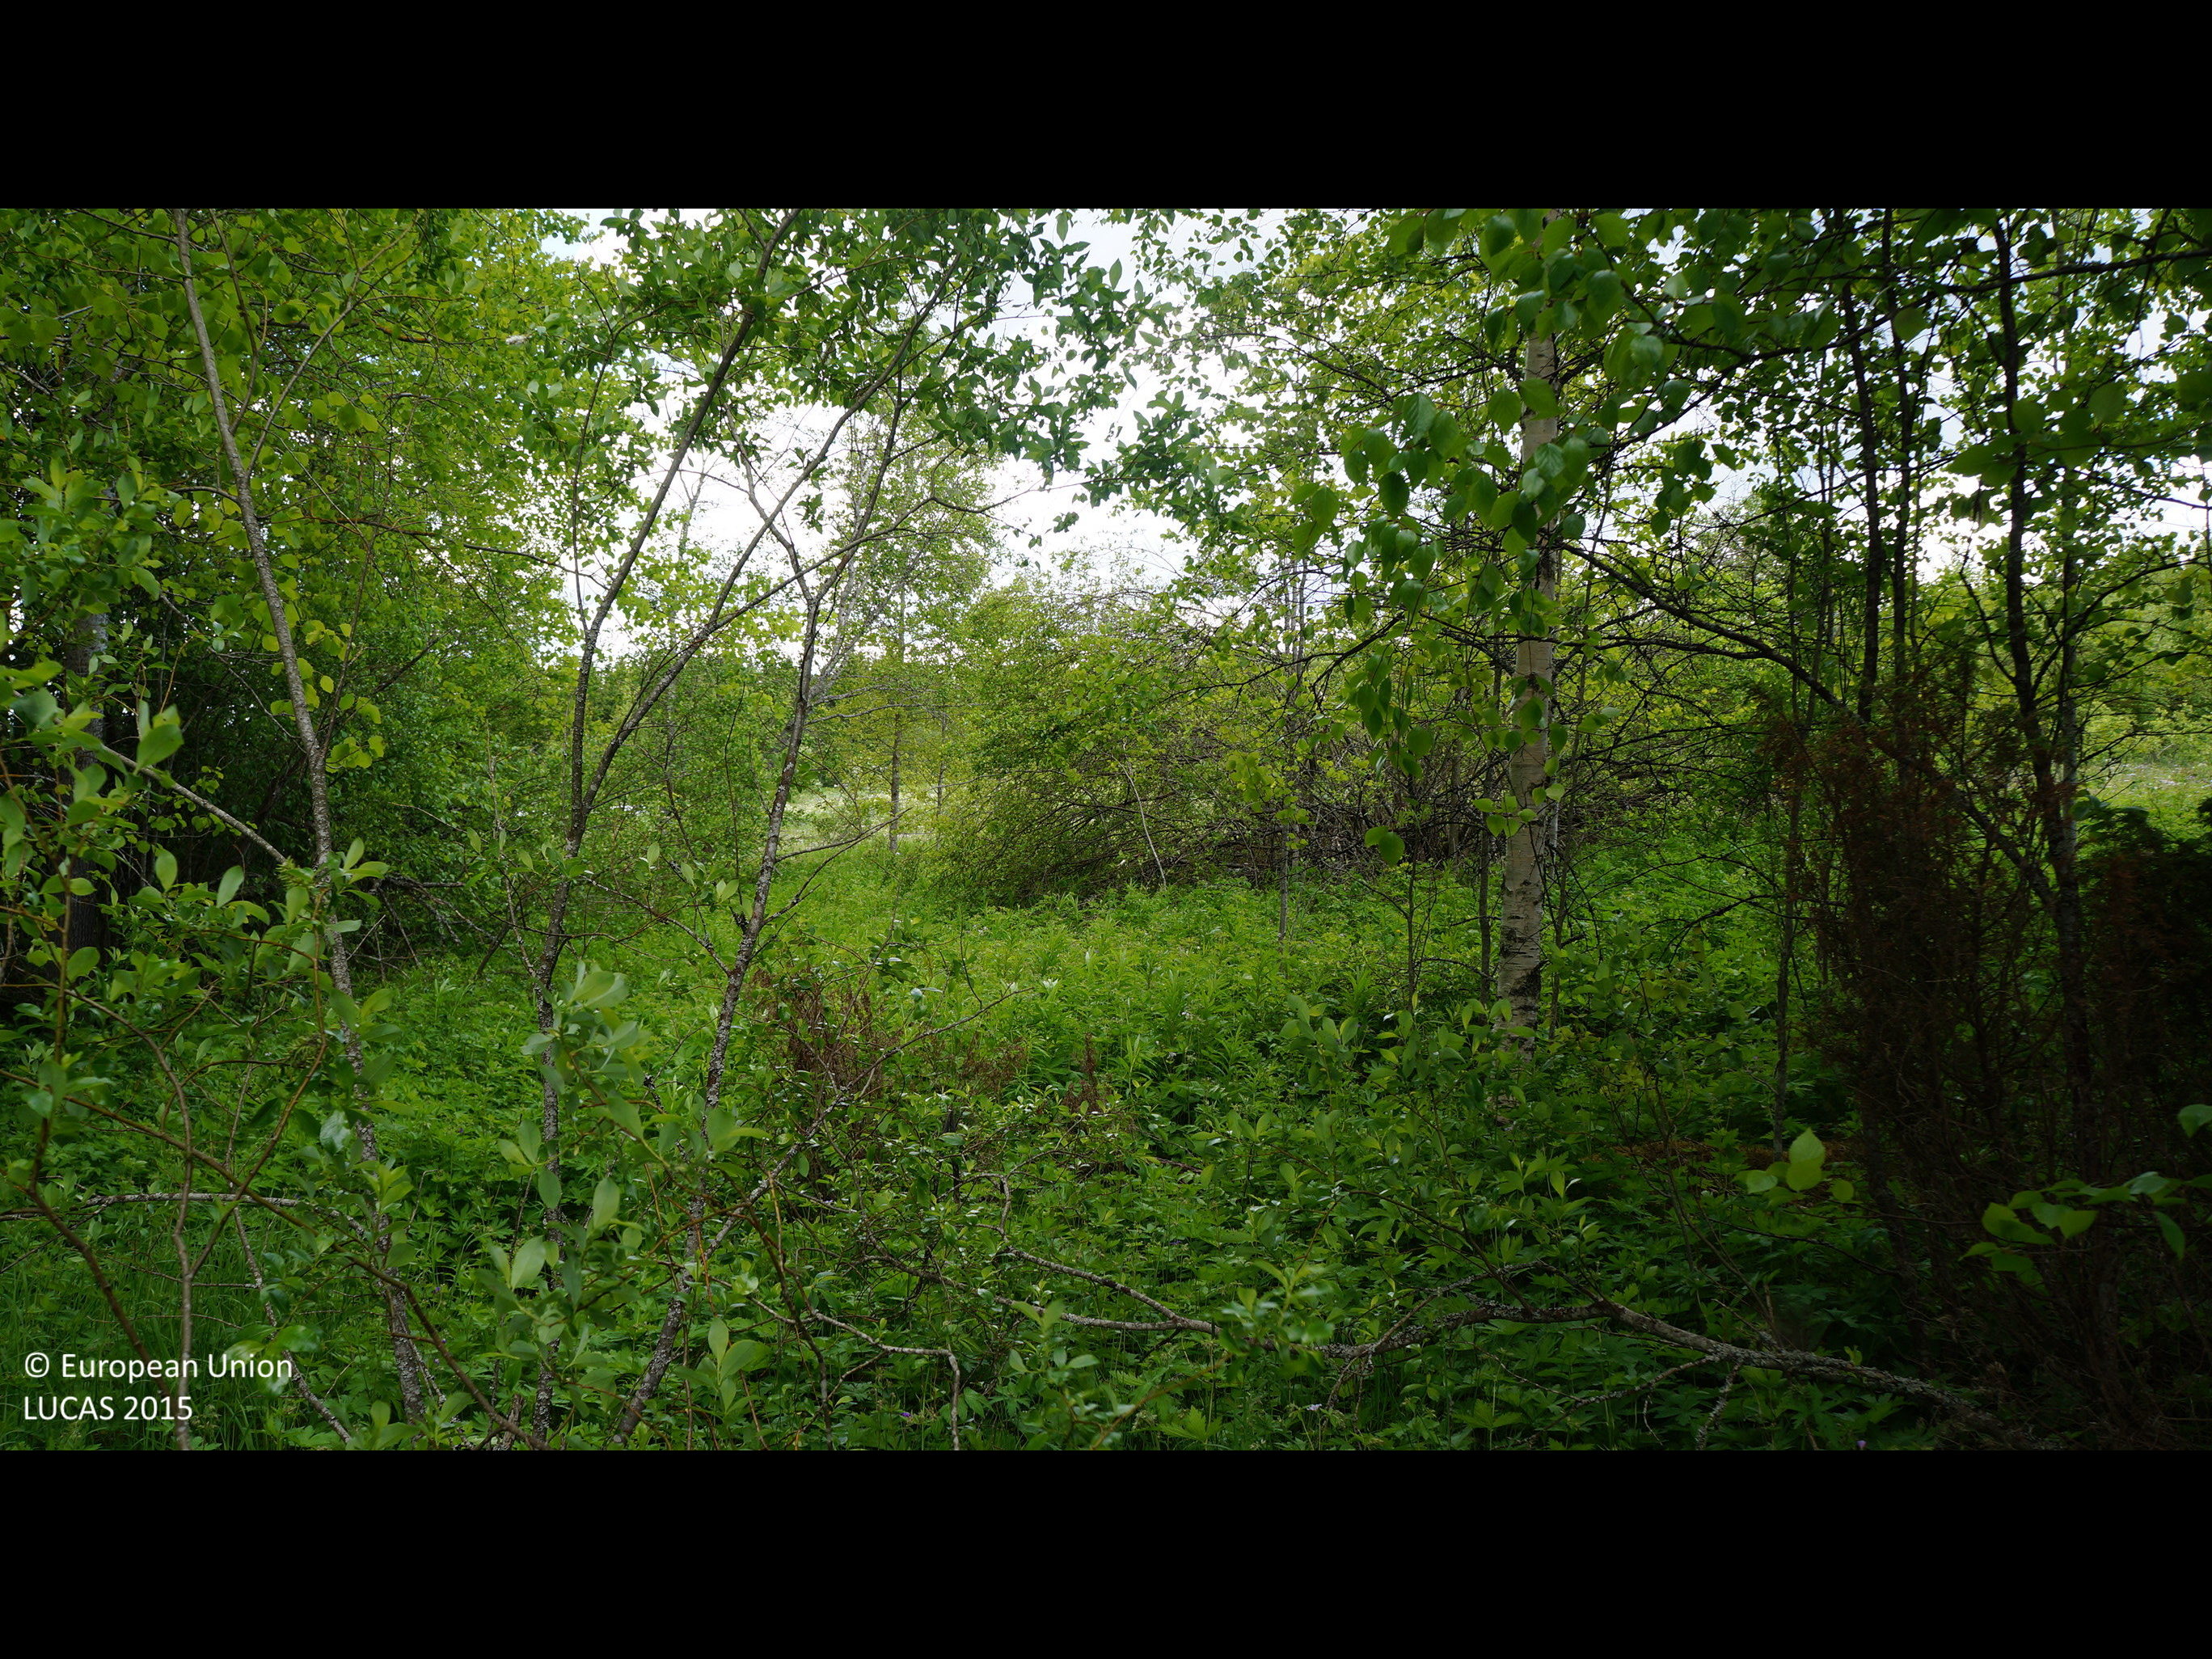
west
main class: Woodland
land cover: Broadleaved woodland
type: boreal forest
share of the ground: 50 - 75 %
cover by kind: broadleaved forest trees 50 %, herbaceous plants 30 %, shrubs 20 %
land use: Forestry
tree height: > 5 m
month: June
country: FI
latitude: 64.1466
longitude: 25.3202
